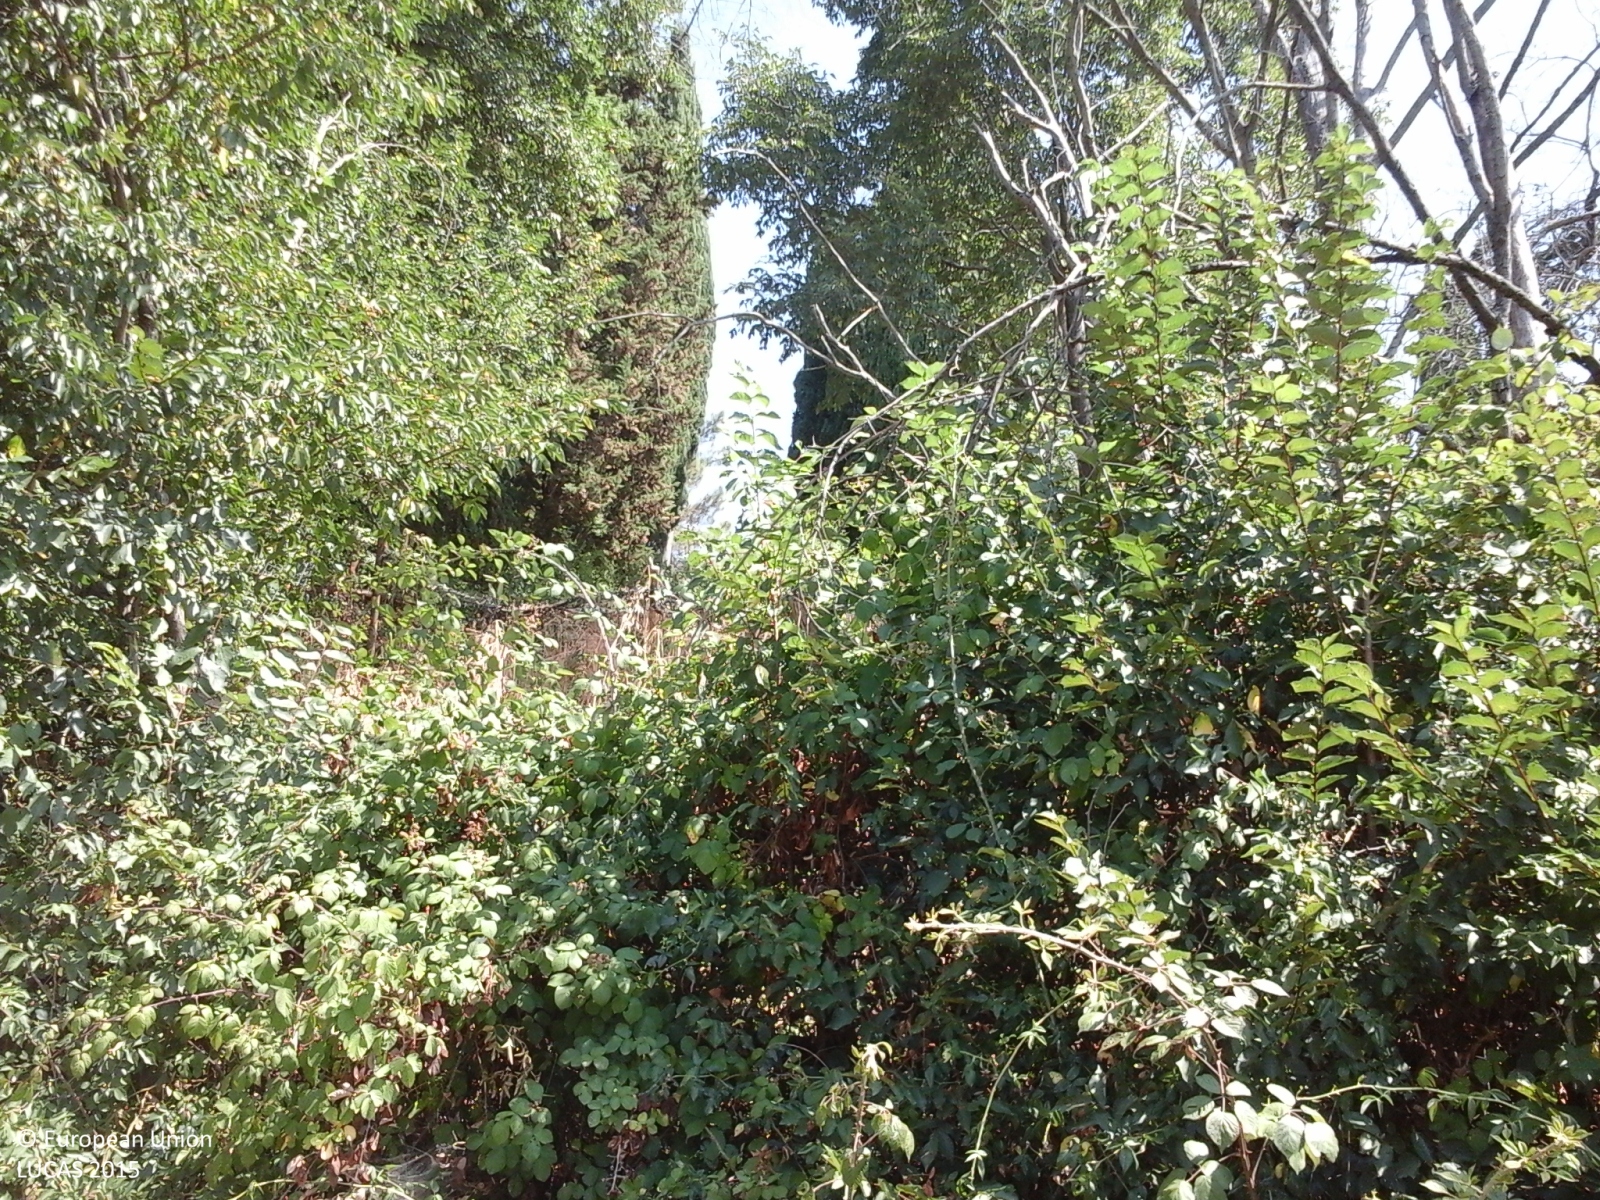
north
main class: Woodland
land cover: Broadleaved woodland
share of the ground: > 75 %
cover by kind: broadleaved forest trees 100 %
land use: Residential
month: July
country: IT
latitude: 43.4646
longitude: 10.6286
